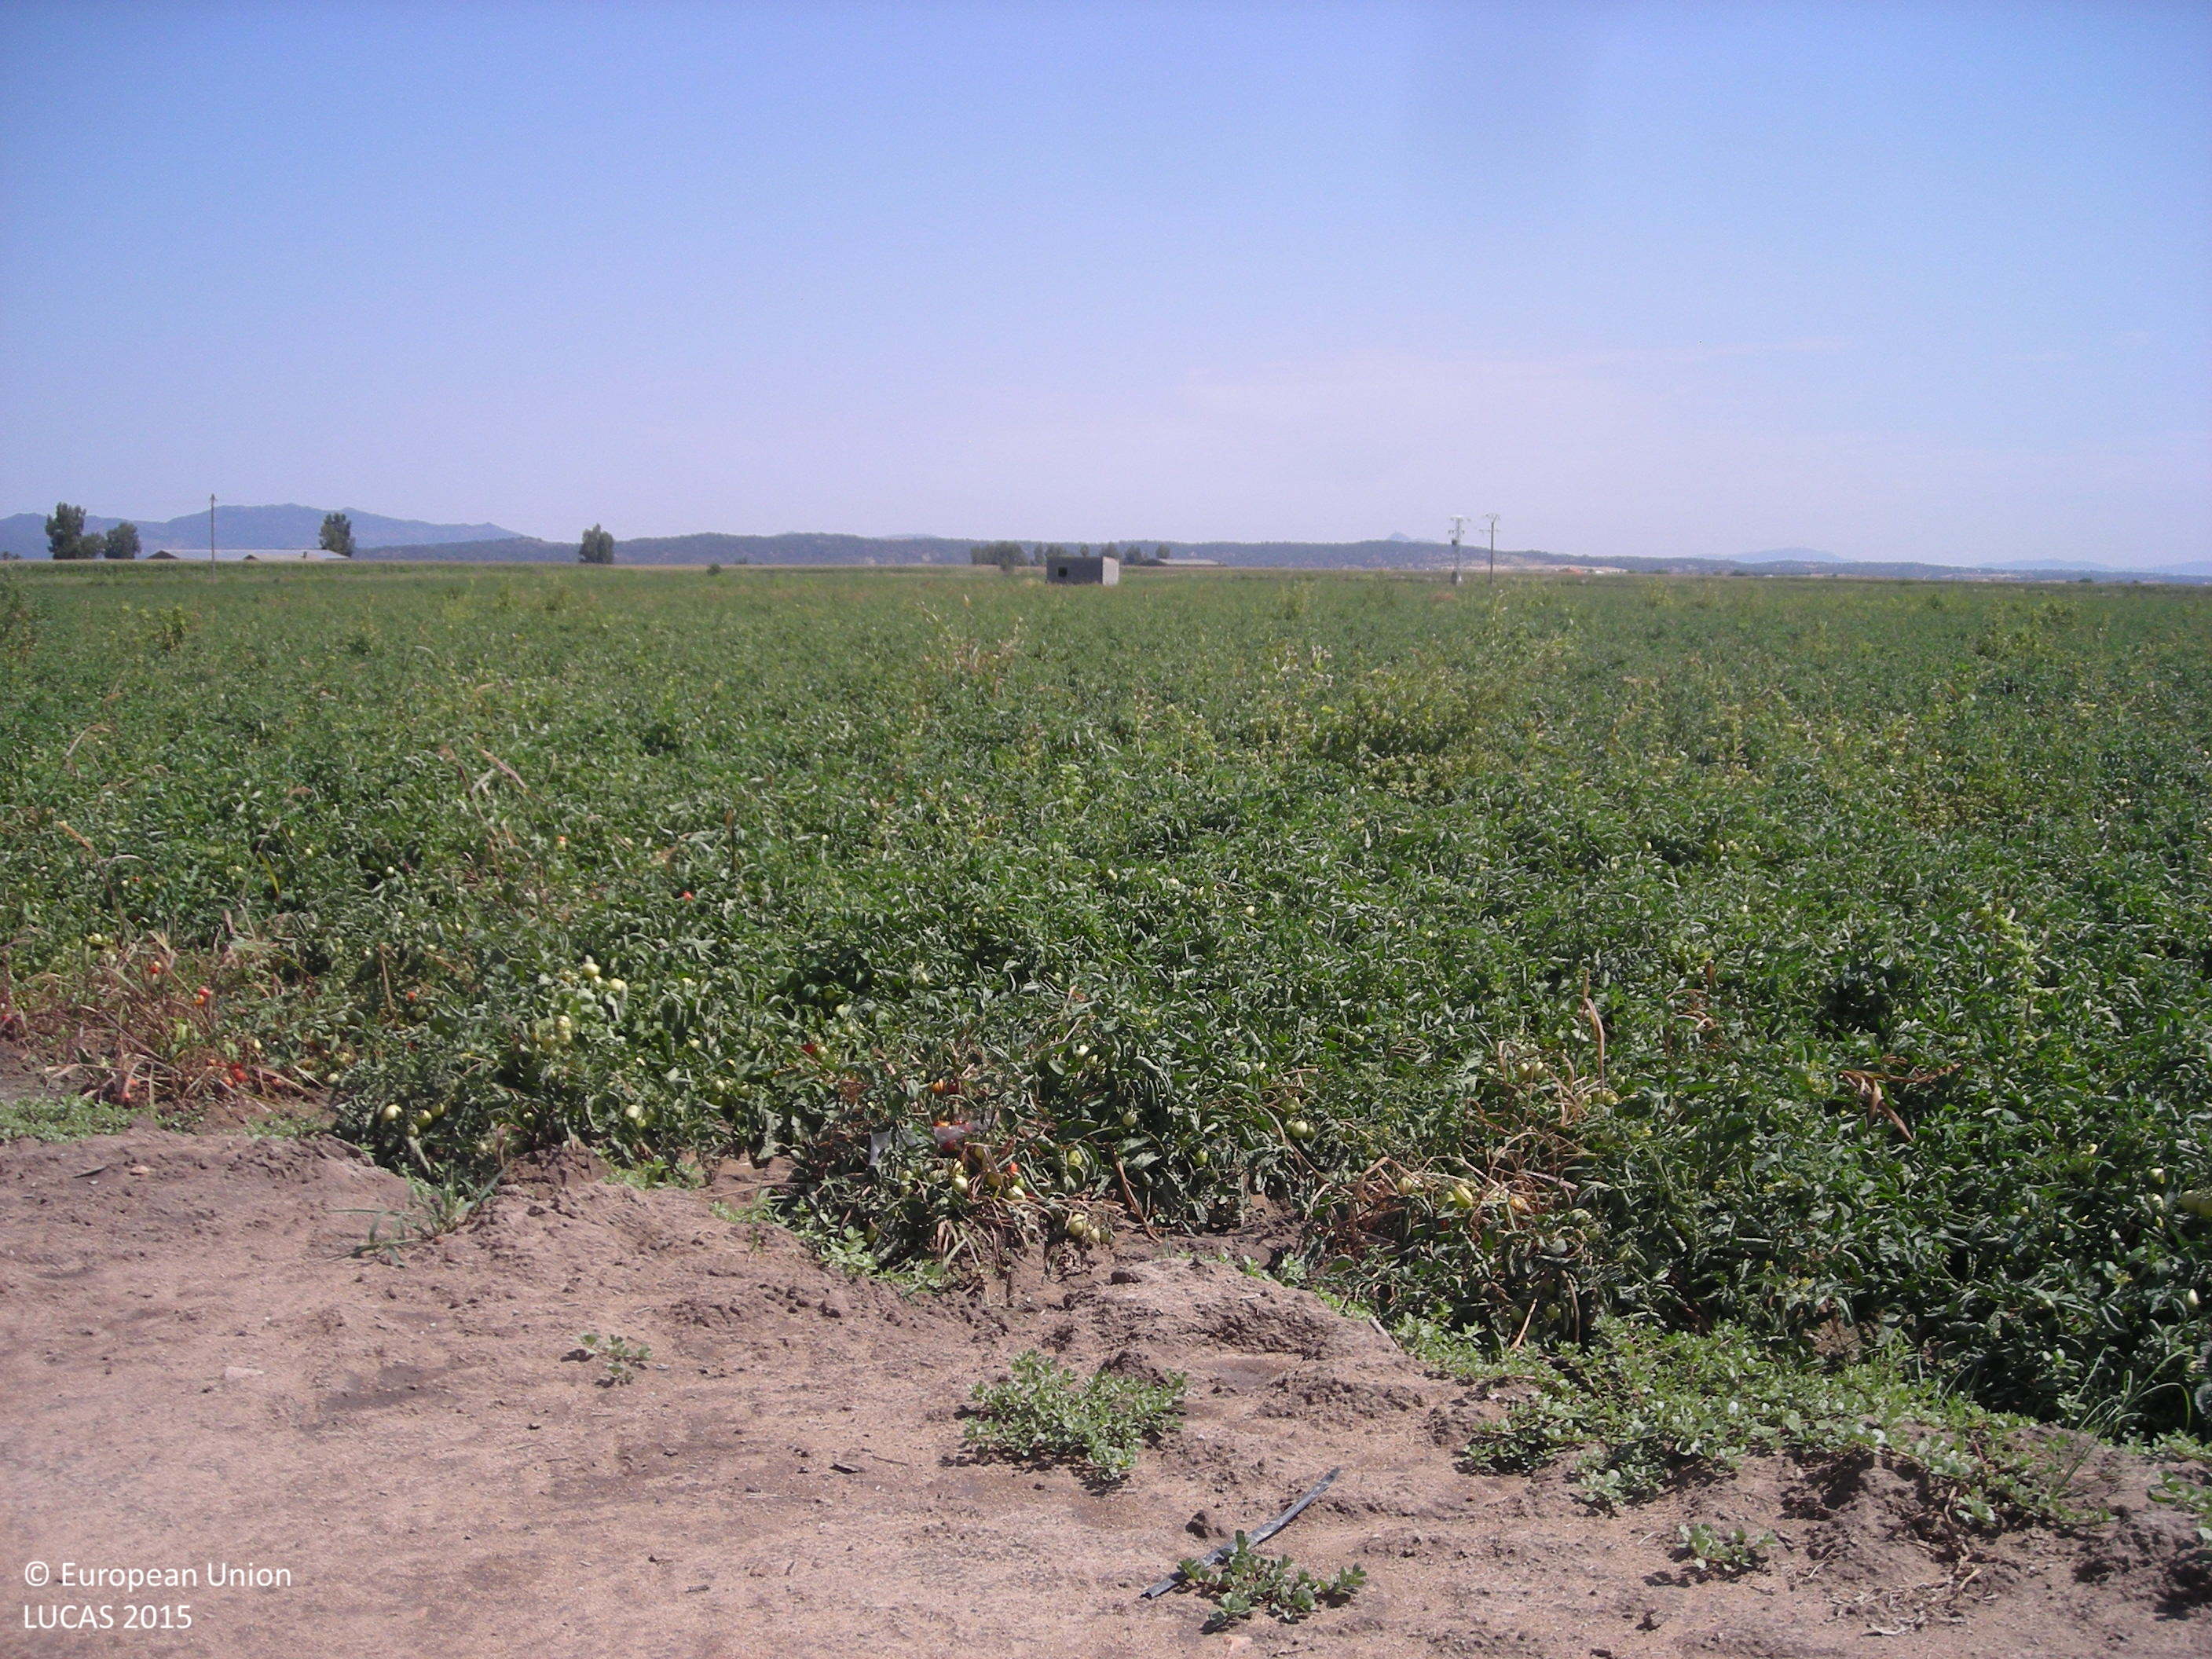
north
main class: Cropland
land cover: Tomatoes
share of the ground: > 75 %
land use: Agriculture (excluding fallow land and kitchen gardens)
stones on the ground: < 10 %
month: July
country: ES
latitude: 39.0923
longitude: -5.9978
